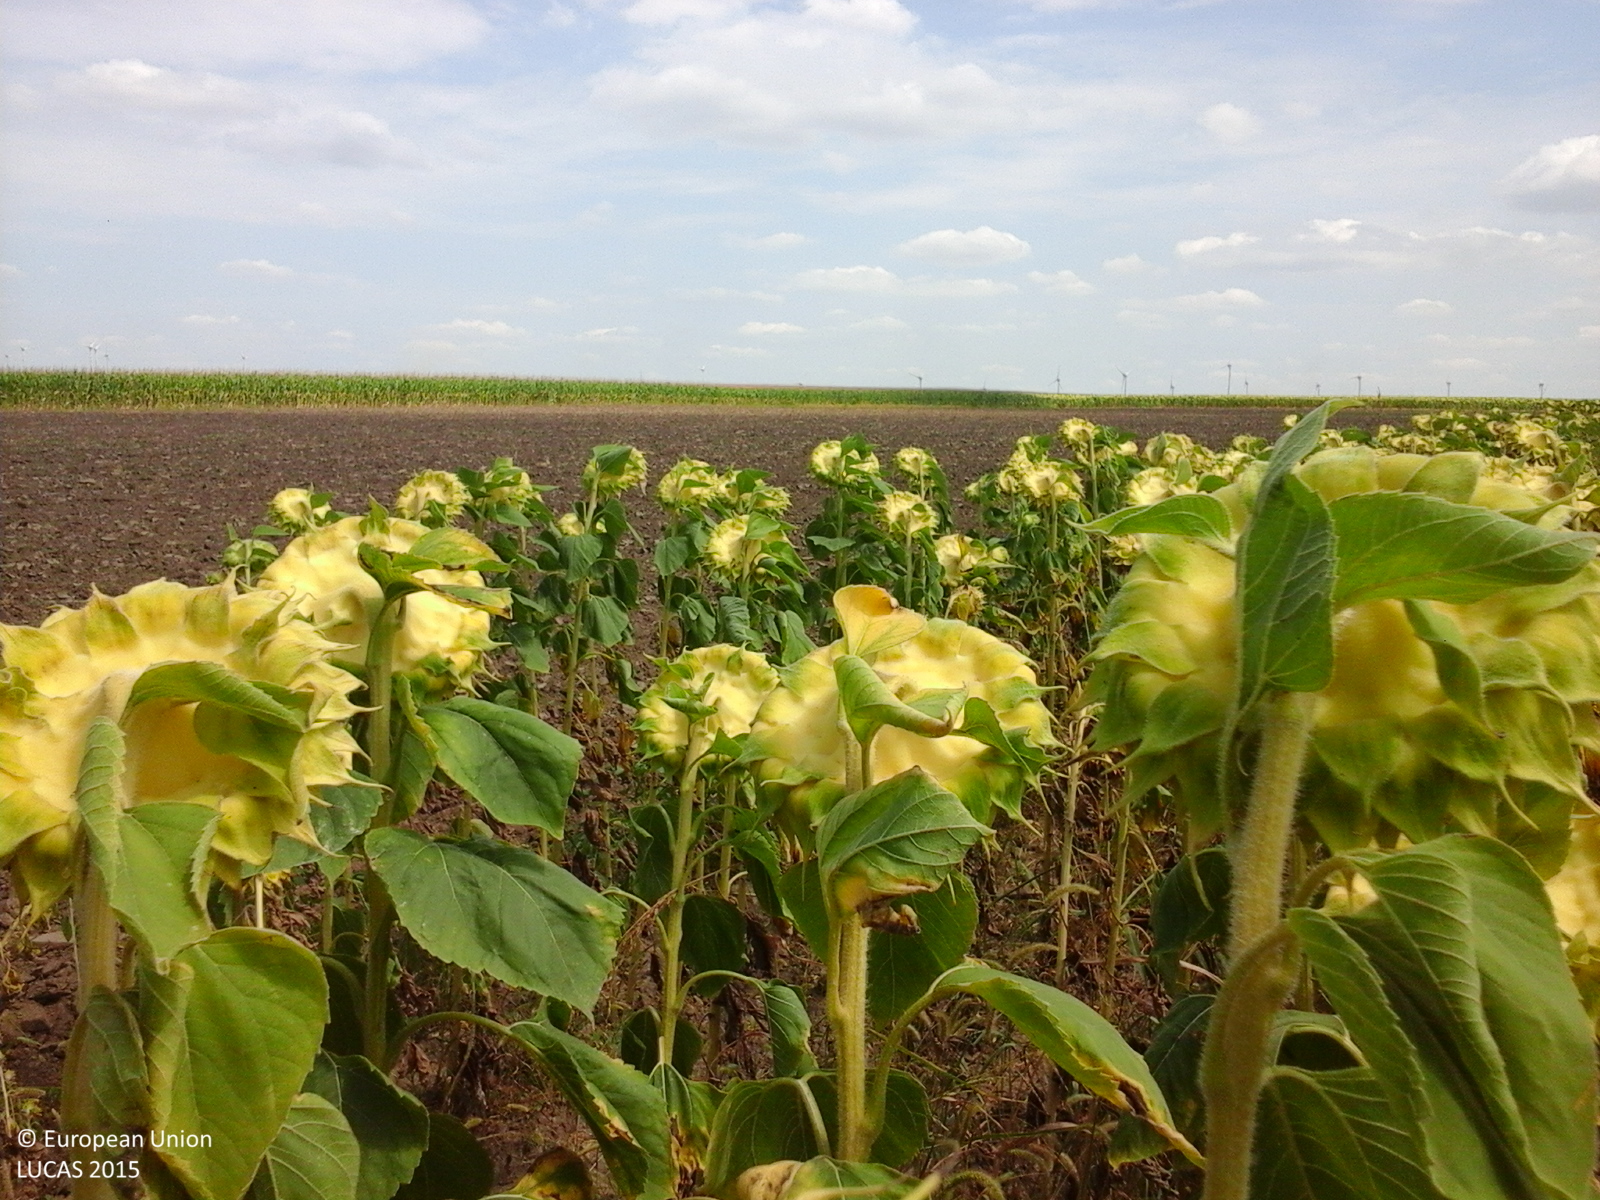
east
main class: Cropland
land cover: Sunflower
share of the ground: > 75 %
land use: Agriculture (excluding fallow land and kitchen gardens)
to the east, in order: Sunflower; Common wheat; Maize; Tracks; Maize; Tracks; Maize
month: August
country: RO
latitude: 44.7945
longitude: 28.1800
